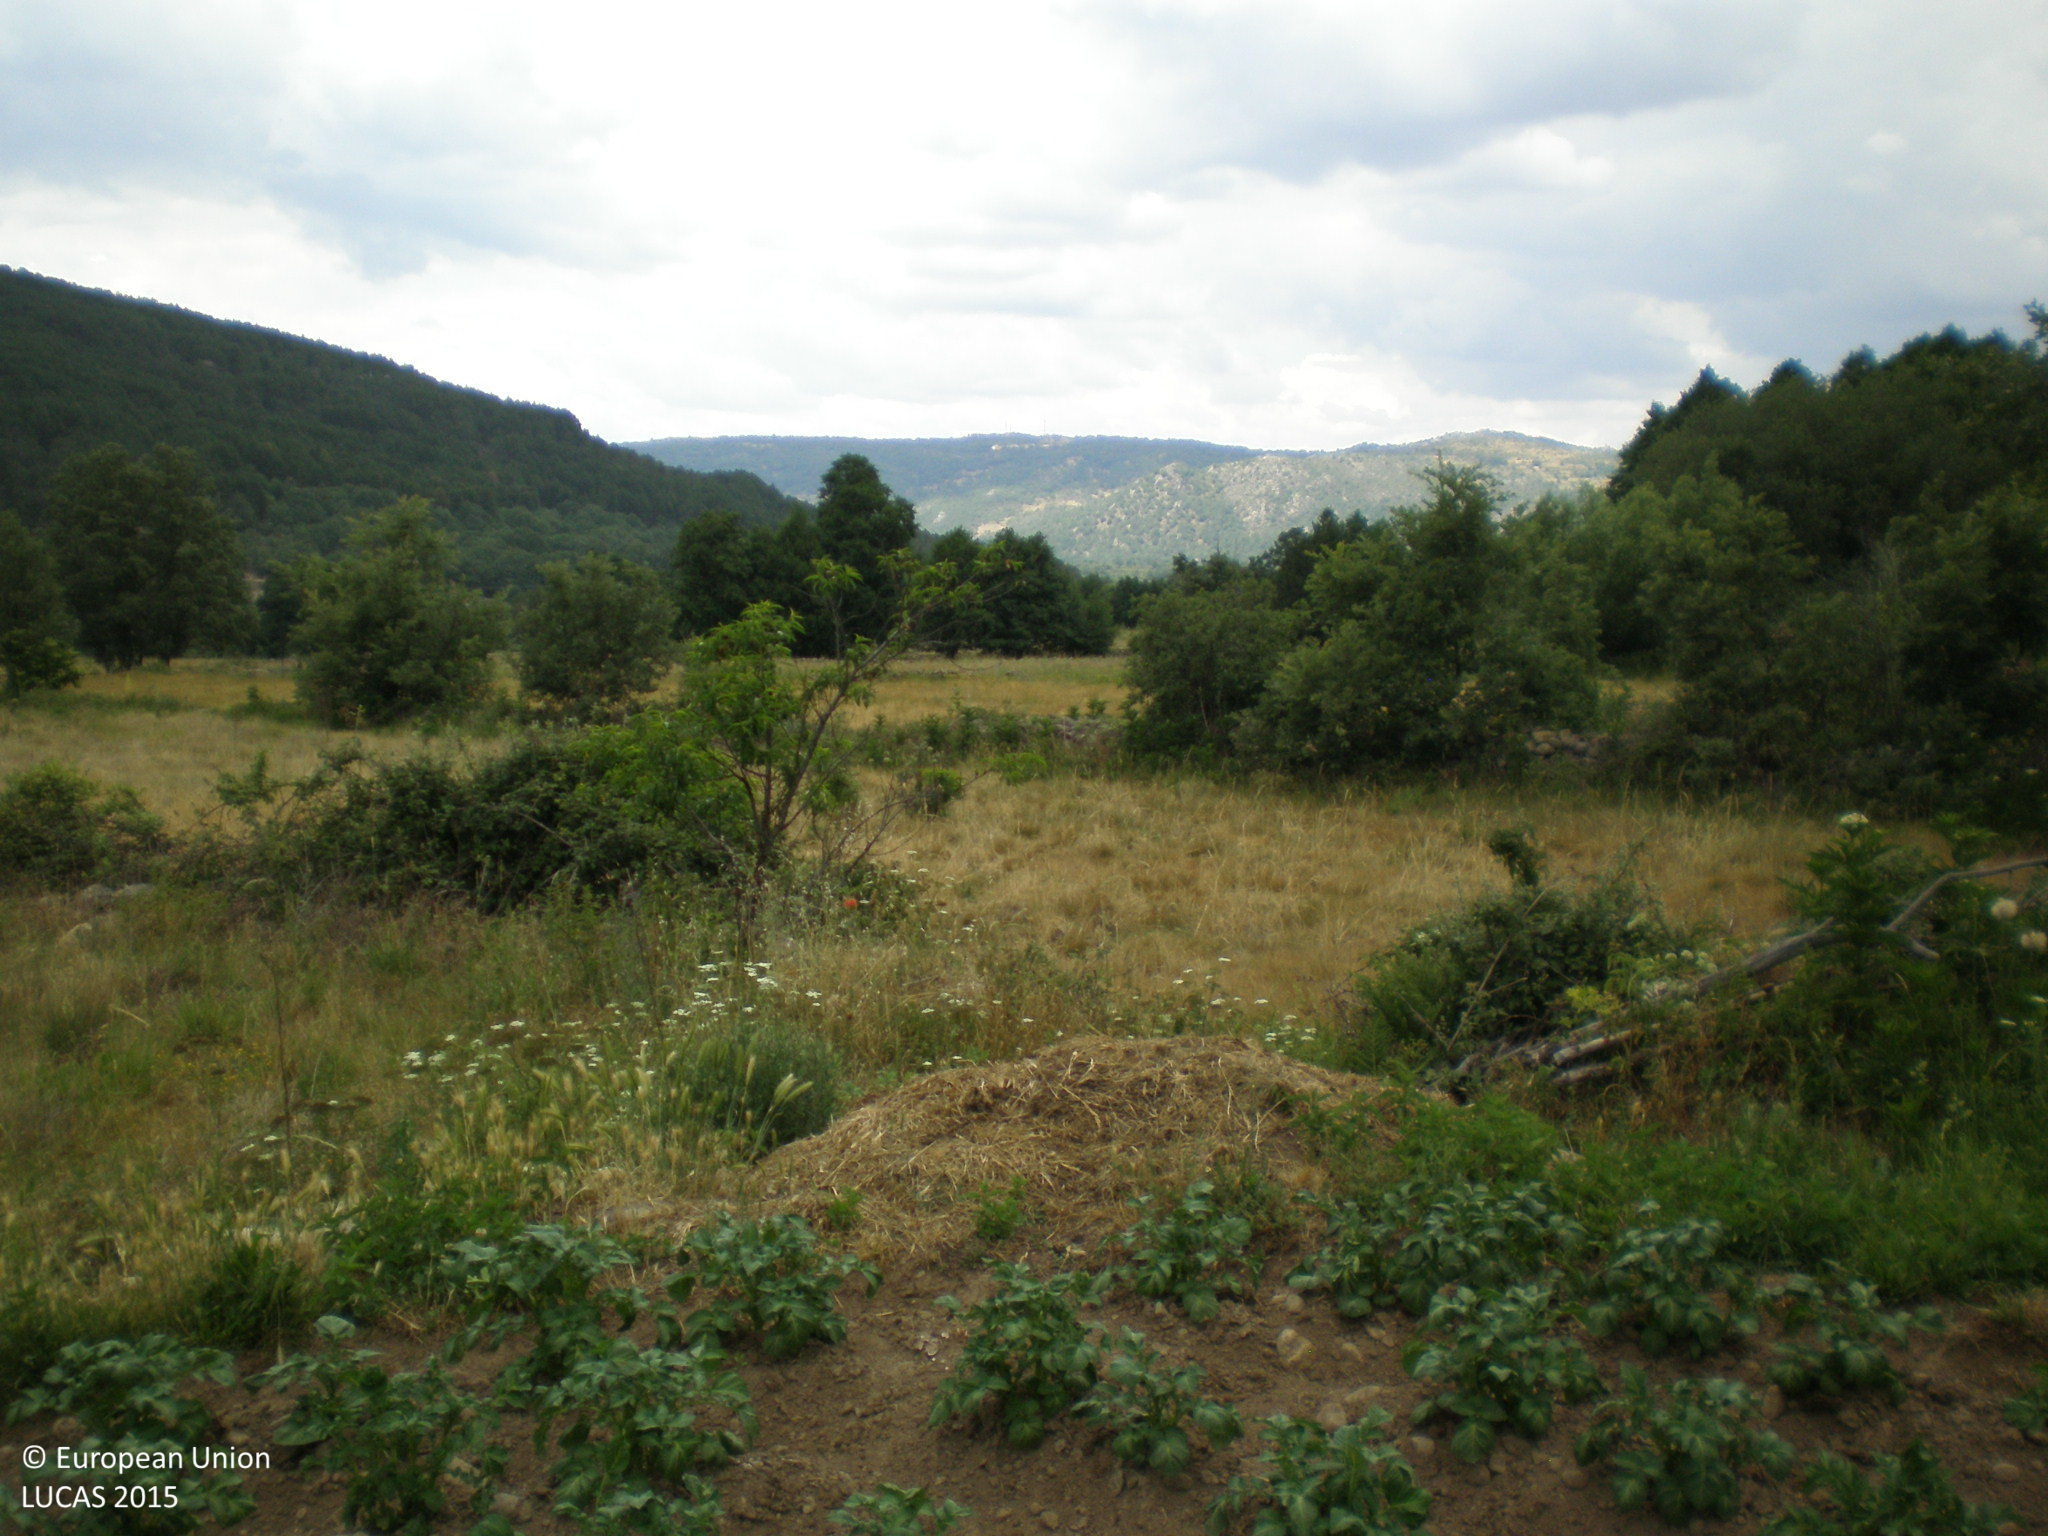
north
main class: Cropland
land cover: Potatoes
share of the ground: < 10 %
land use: Agriculture (excluding fallow land and kitchen gardens)
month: June
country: ES
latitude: 40.2760
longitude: -5.5060
